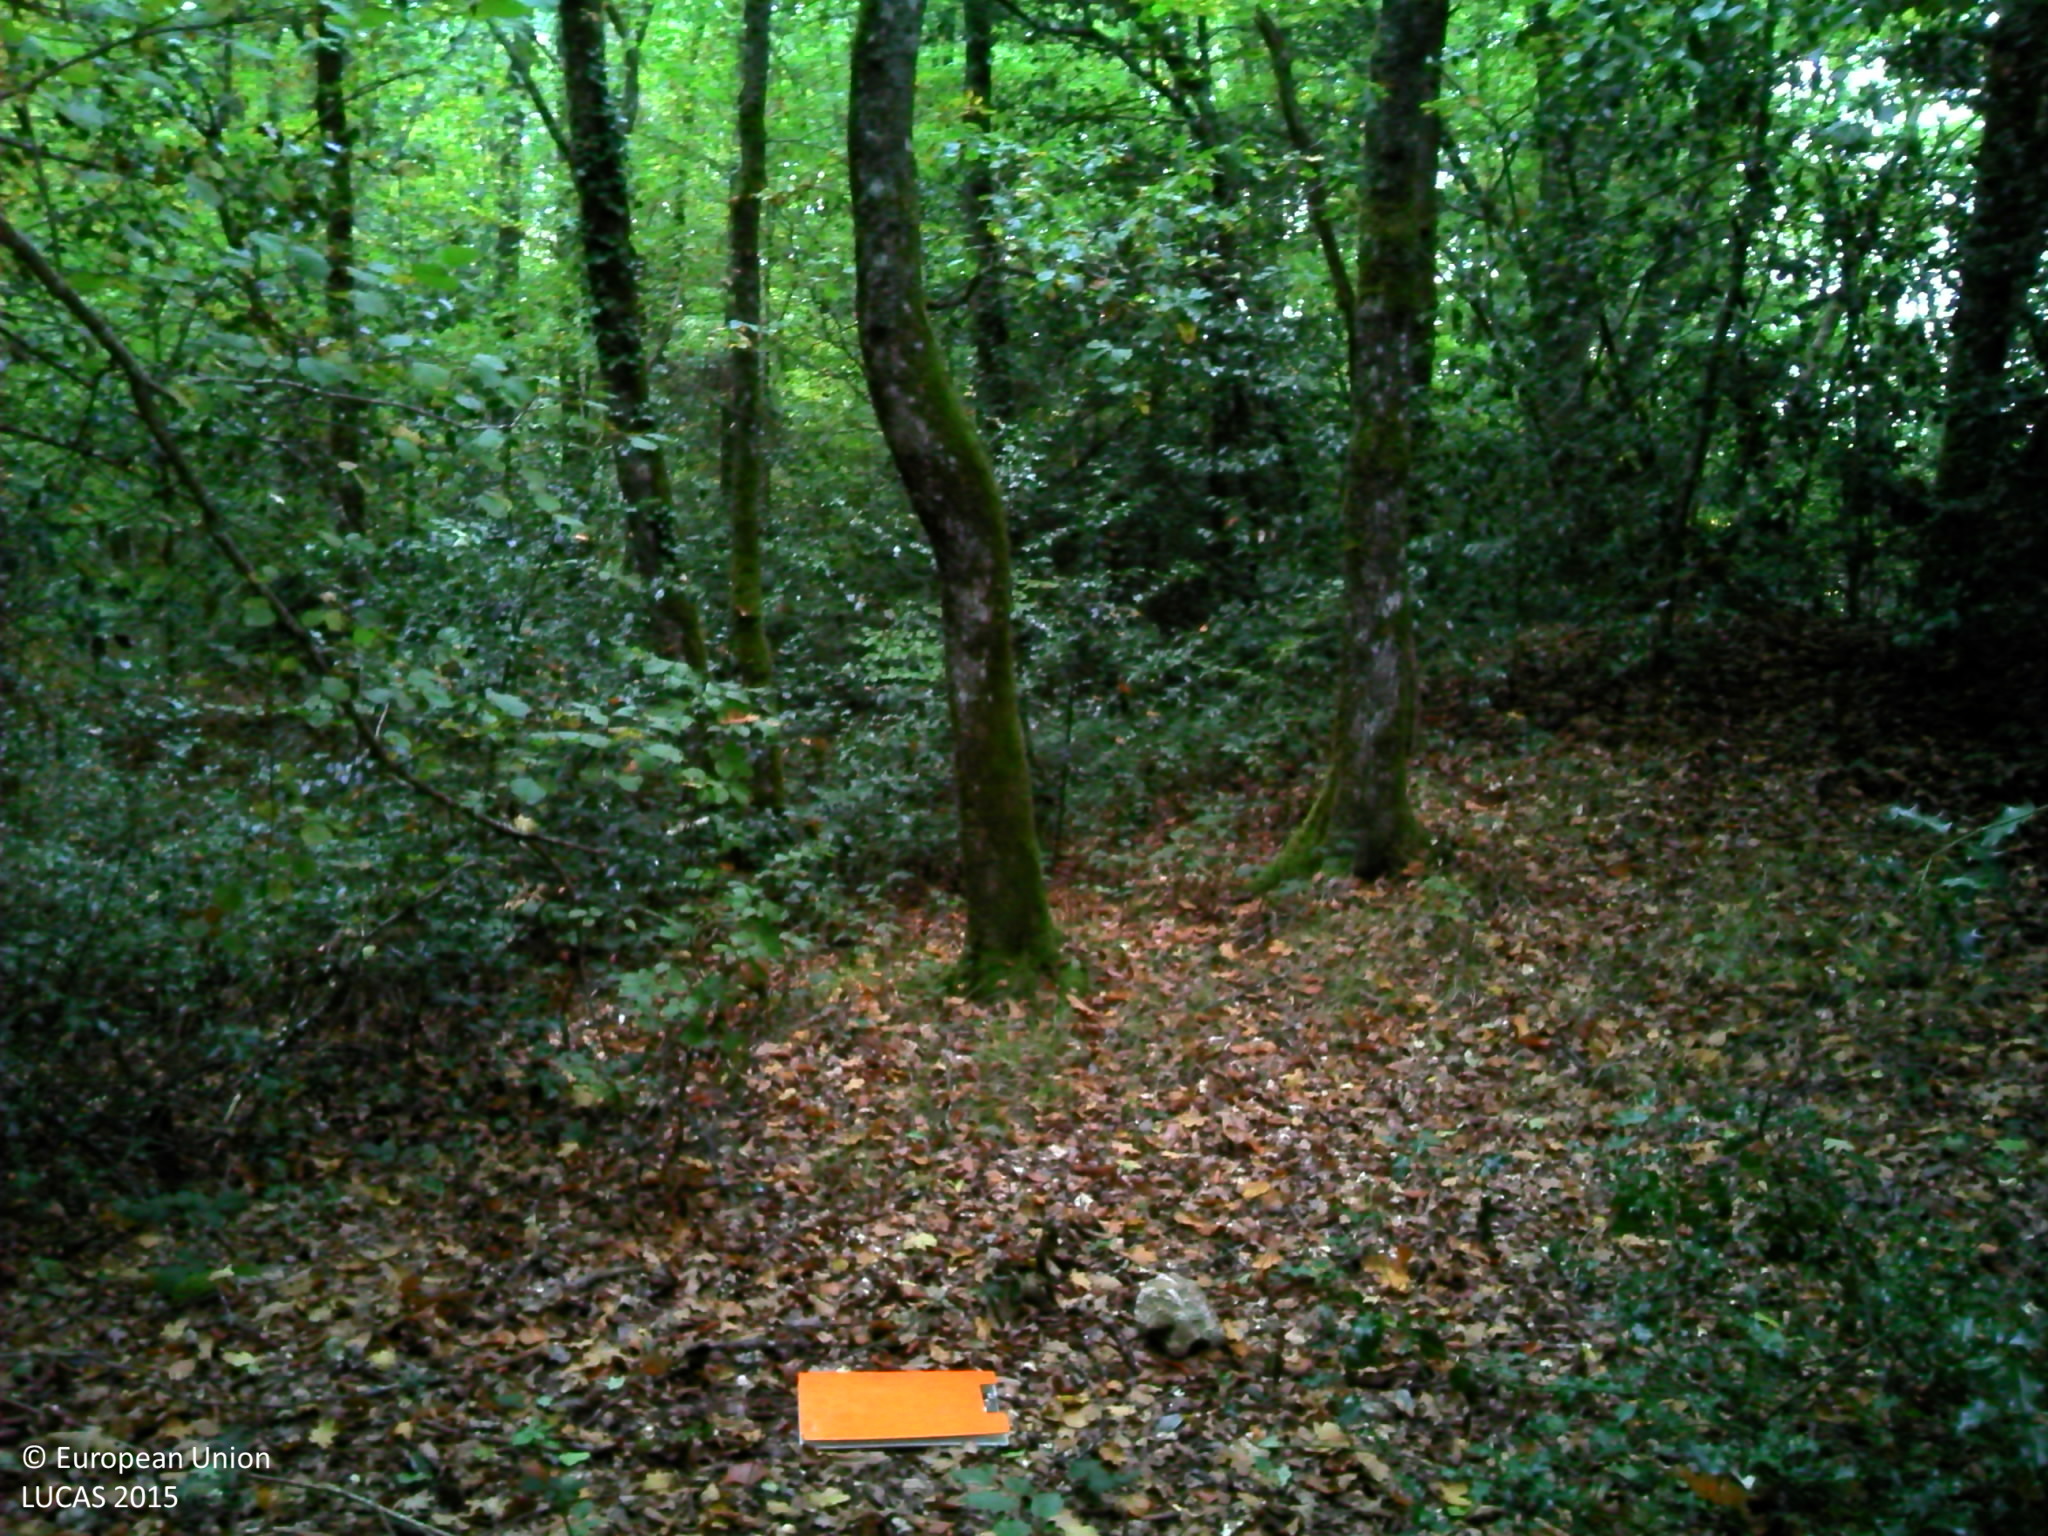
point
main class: Woodland
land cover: Broadleaved woodland
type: beech forest
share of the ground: > 75 %
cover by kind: broadleaved forest trees 85 %, herbaceous plants 15 %
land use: Forestry
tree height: > 5 m
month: October
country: FR
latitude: 45.9124
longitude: 2.8433
